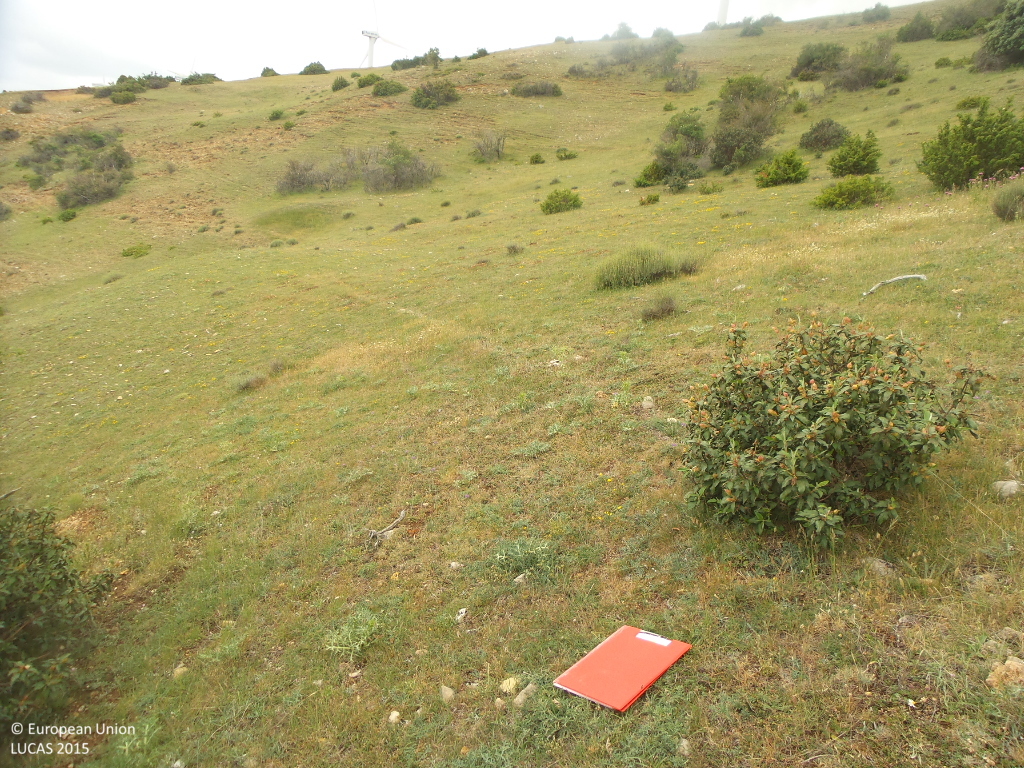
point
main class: Shrubland
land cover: Shrubland without tree cover
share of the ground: 10 - 25 %
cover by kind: herbaceous plants 85 %, shrubs 10 %, unconsolidated bare surface 5 %
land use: Agriculture (excluding fallow land and kitchen gardens)
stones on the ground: < 10 %
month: June
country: ES
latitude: 41.2969
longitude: -3.1658
